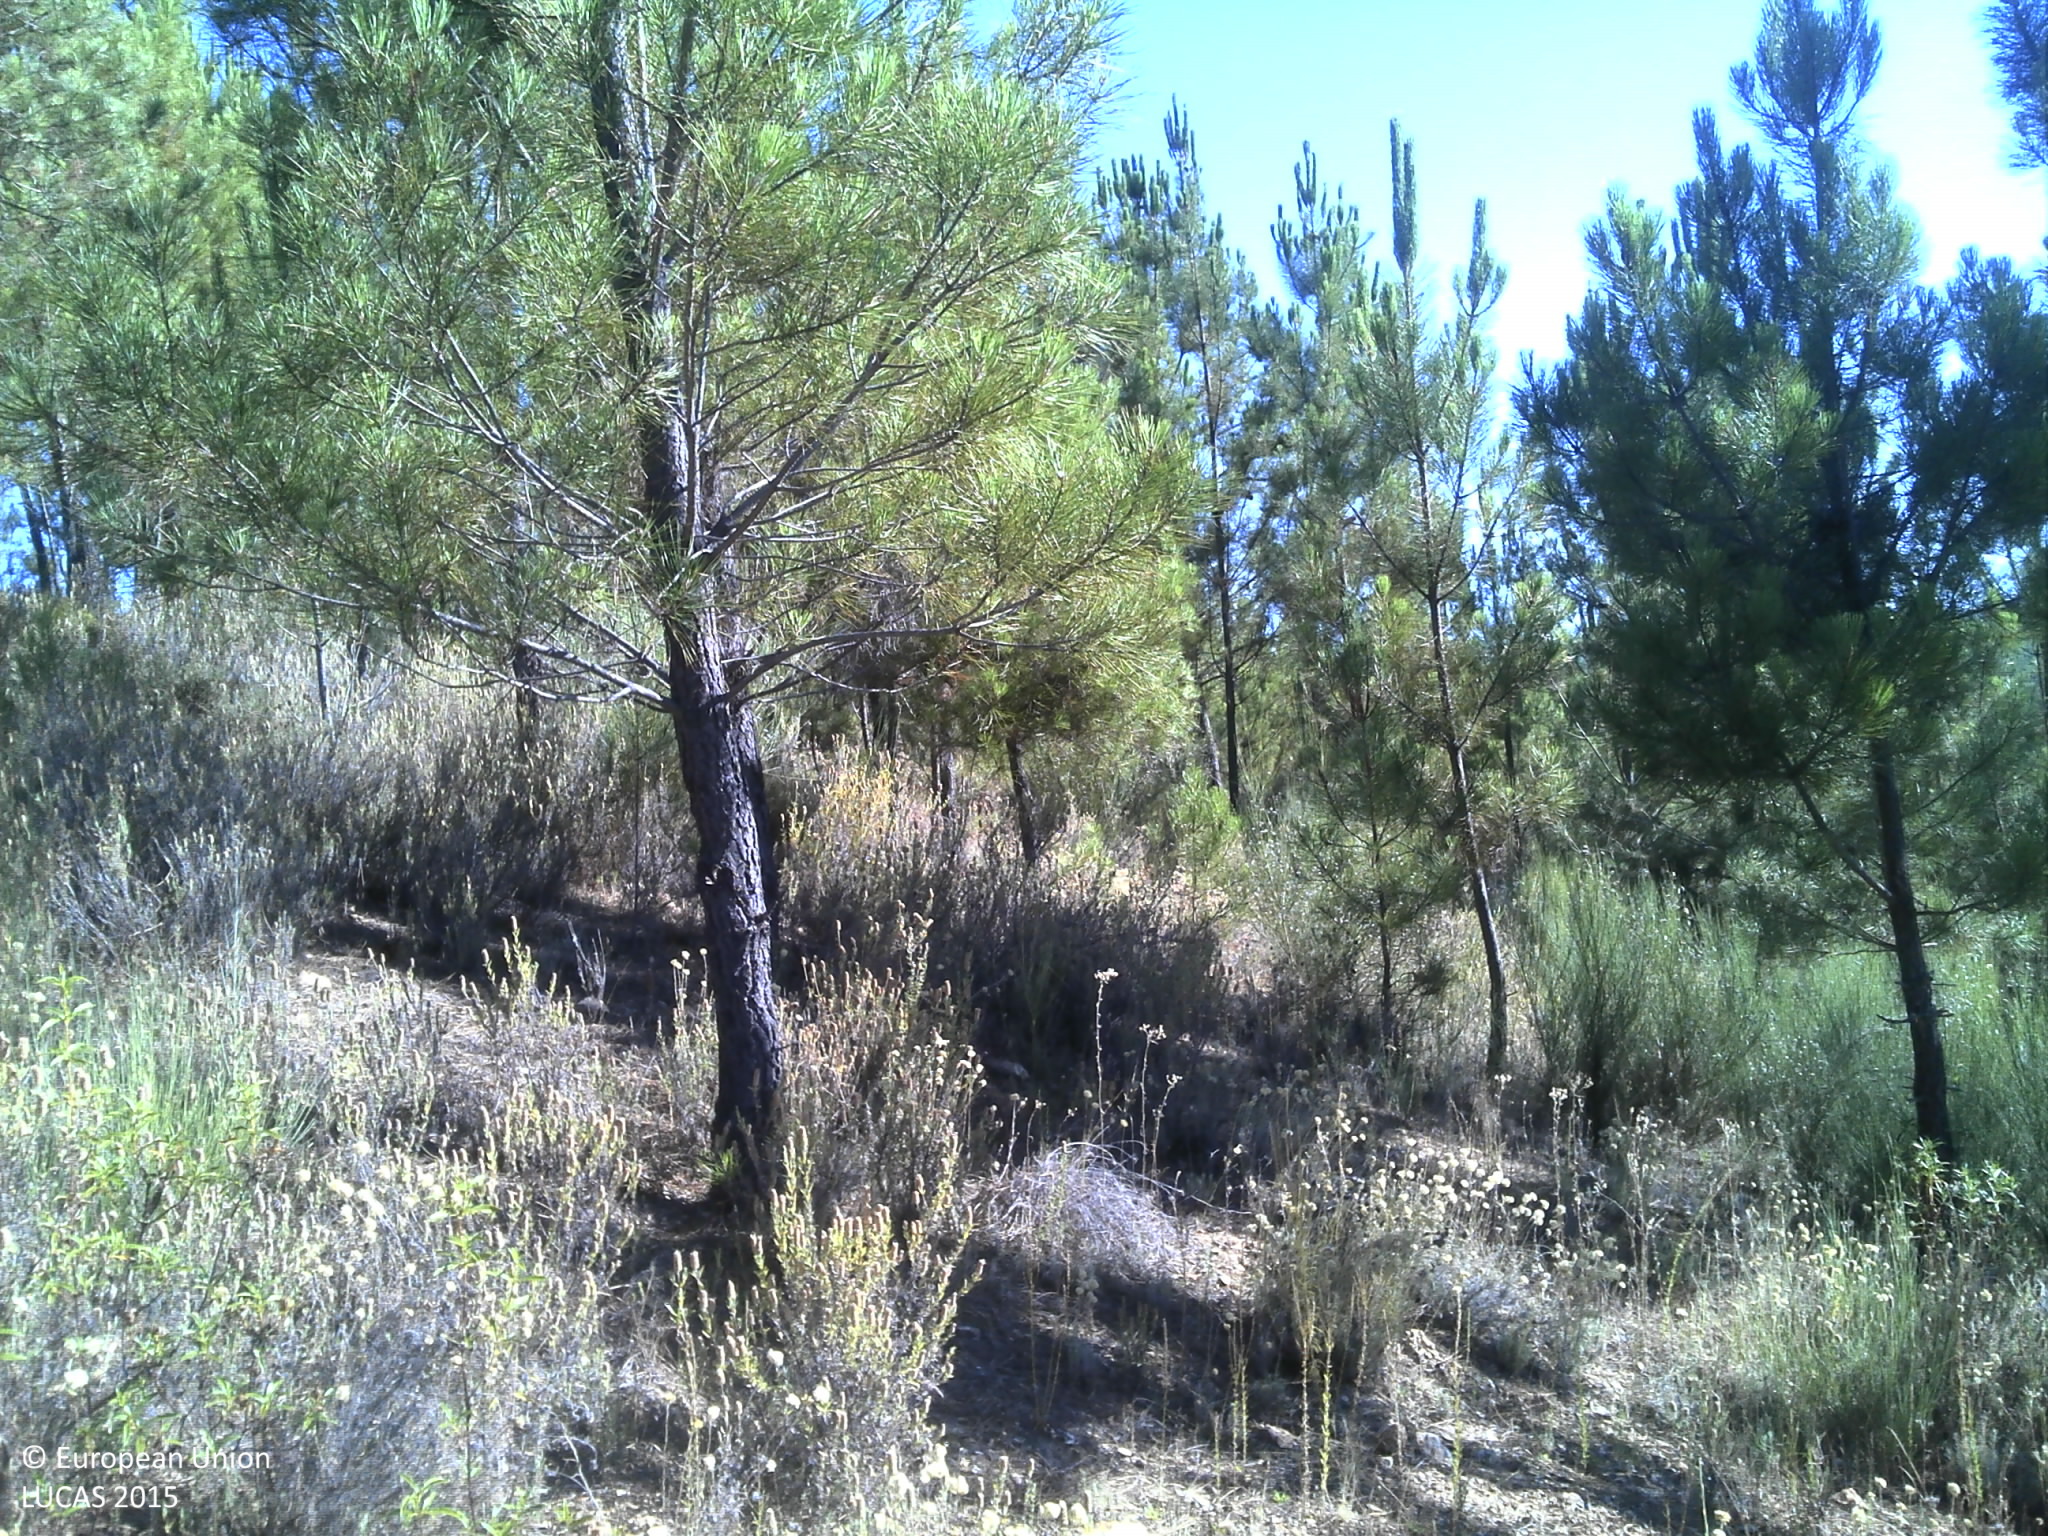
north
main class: Woodland
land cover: Pine dominated coniferous woodland
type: coniferous forest of the mediterranean region
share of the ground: 25 - 50 %
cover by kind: unconsolidated bare surface 40 %, coniferous forest trees 35 %, shrubs 25 %
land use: Forestry
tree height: > 5 m
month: July
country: PT
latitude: 39.9806
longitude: -7.6592
